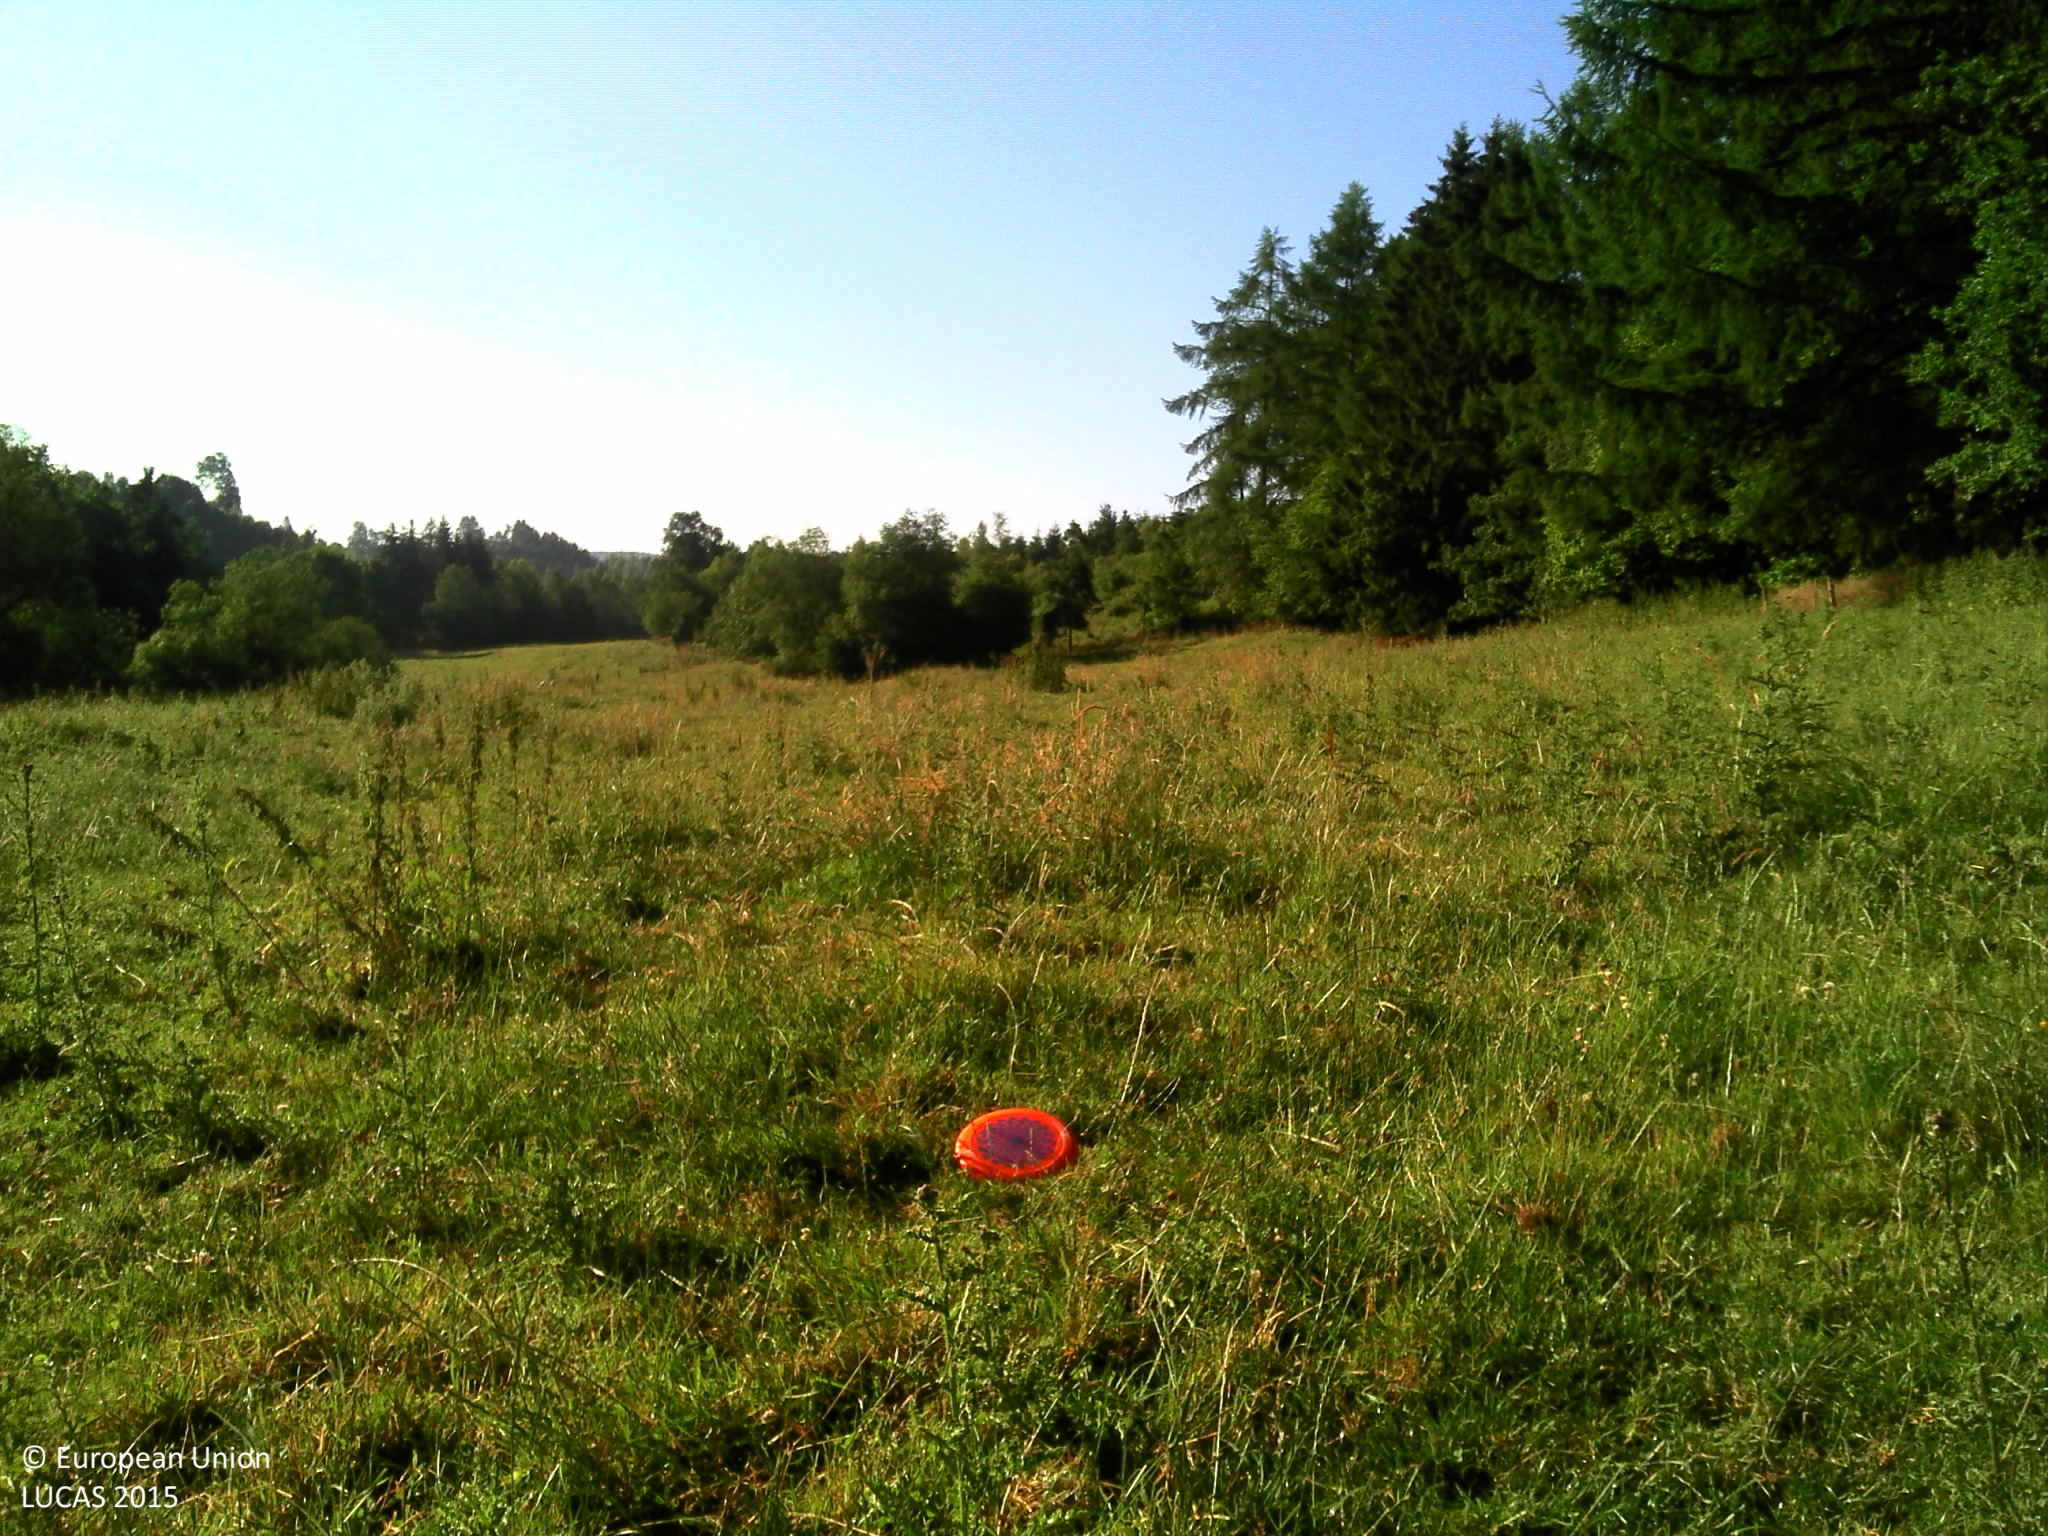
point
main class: Grassland
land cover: Grassland without tree/shrub cover
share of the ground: > 75 %
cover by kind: herbaceous plants 100 %
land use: Agriculture (excluding fallow land and kitchen gardens)
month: July
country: BE
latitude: 50.1182
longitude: 5.6210
